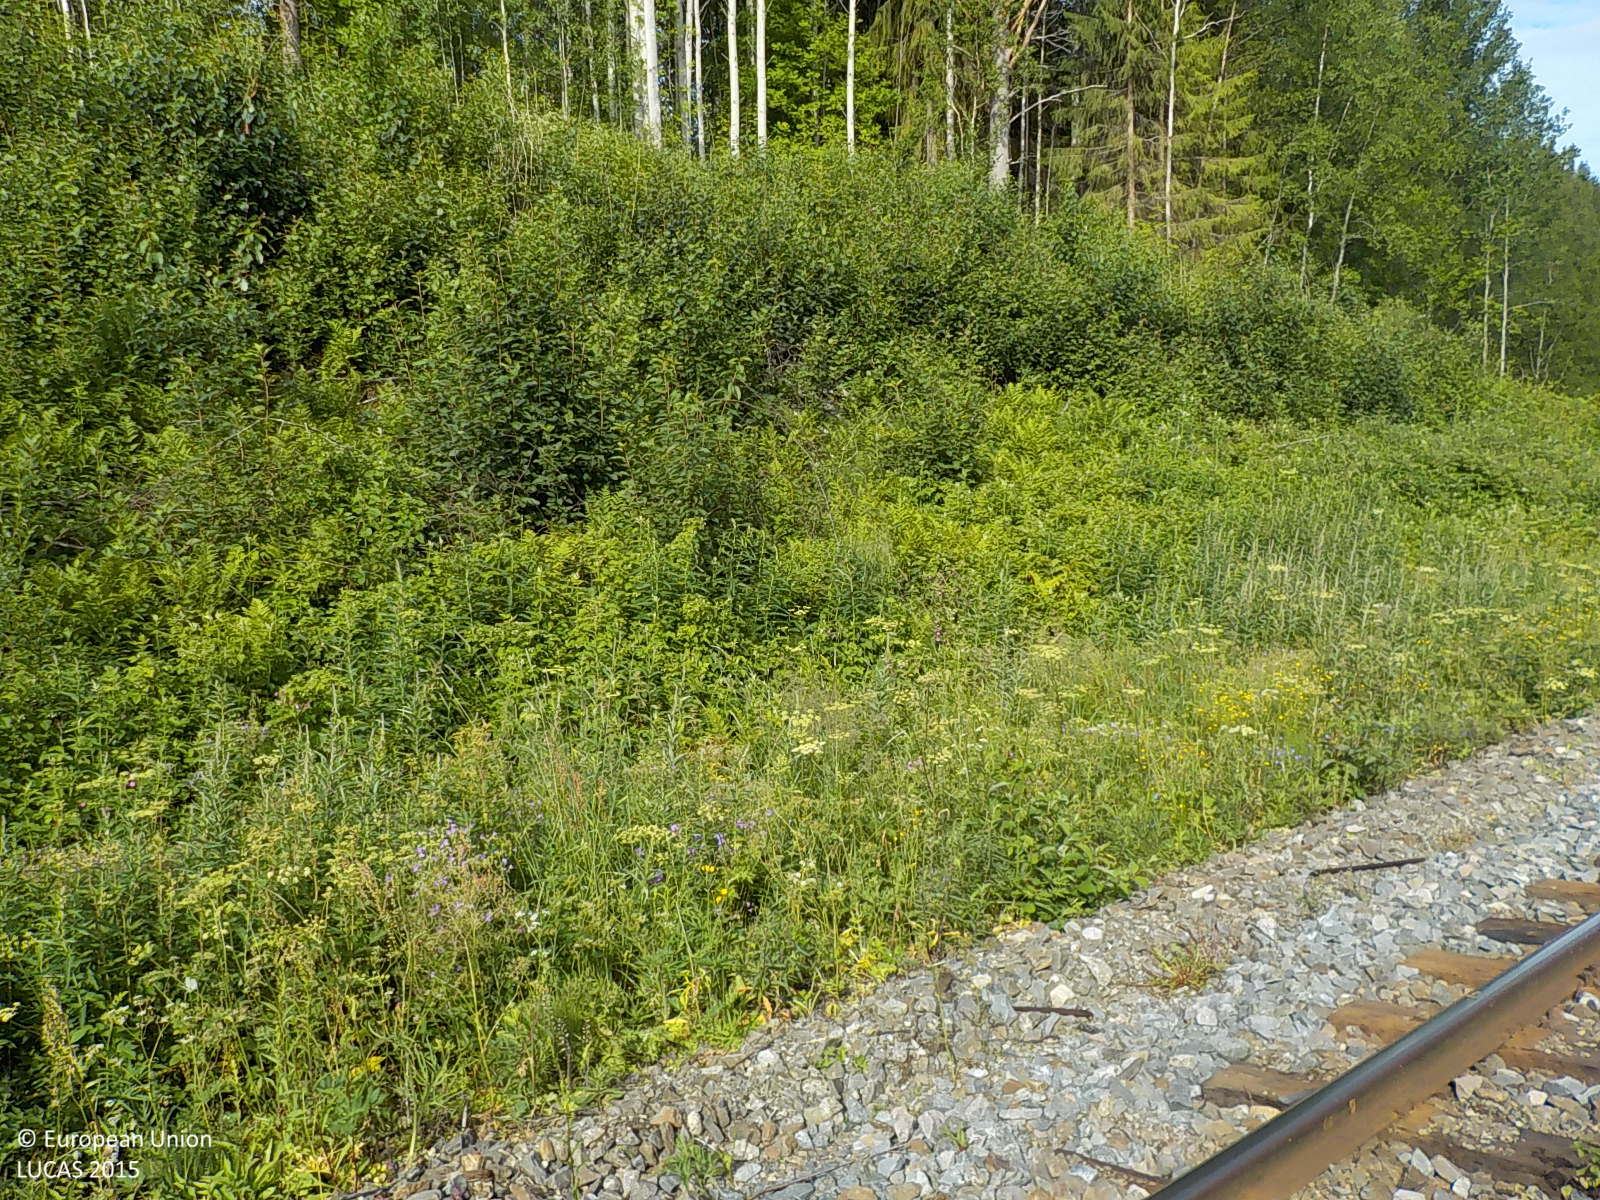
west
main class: Woodland
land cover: Broadleaved woodland
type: boreal forest
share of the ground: 50 - 75 %
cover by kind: broadleaved forest trees 50 %, herbaceous plants 50 %
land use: Forestry
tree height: < 5 m
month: July
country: SE
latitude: 63.1817
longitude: 17.2272
